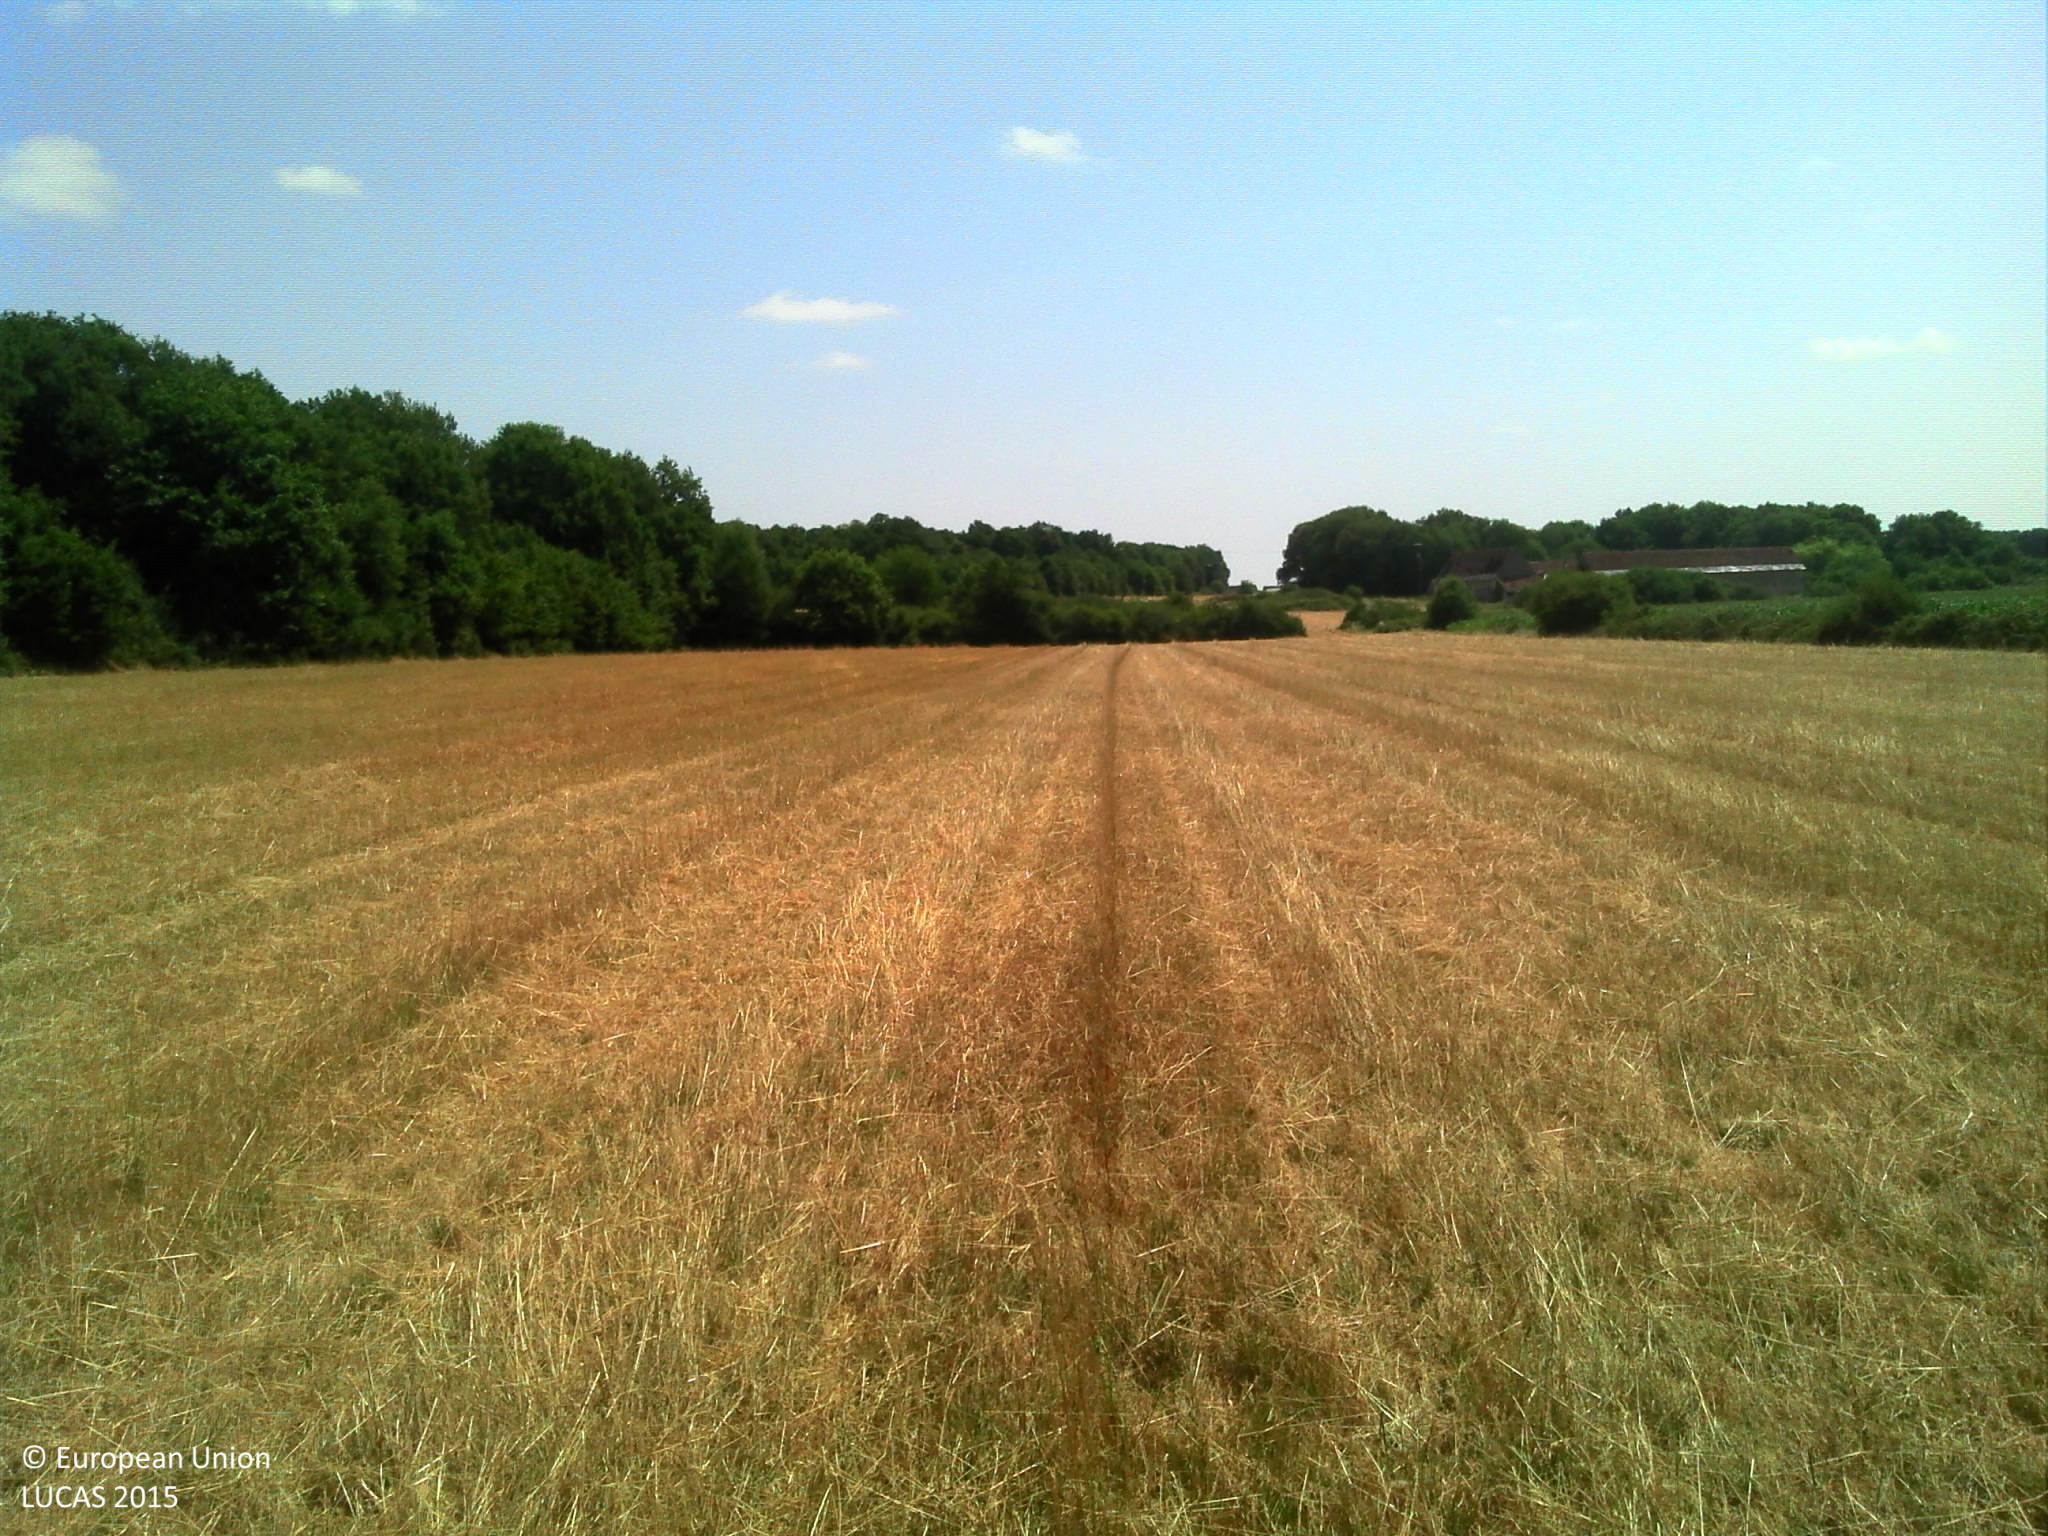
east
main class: Grassland
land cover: Grassland without tree/shrub cover
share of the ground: > 75 %
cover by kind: herbaceous plants 100 %
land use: Agriculture (excluding fallow land and kitchen gardens)
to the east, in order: Grassland without tree/shrub cover; Broadleaved woodland; Grassland without tree/shrub cover
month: July
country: FR
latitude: 47.1822
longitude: 0.5450
